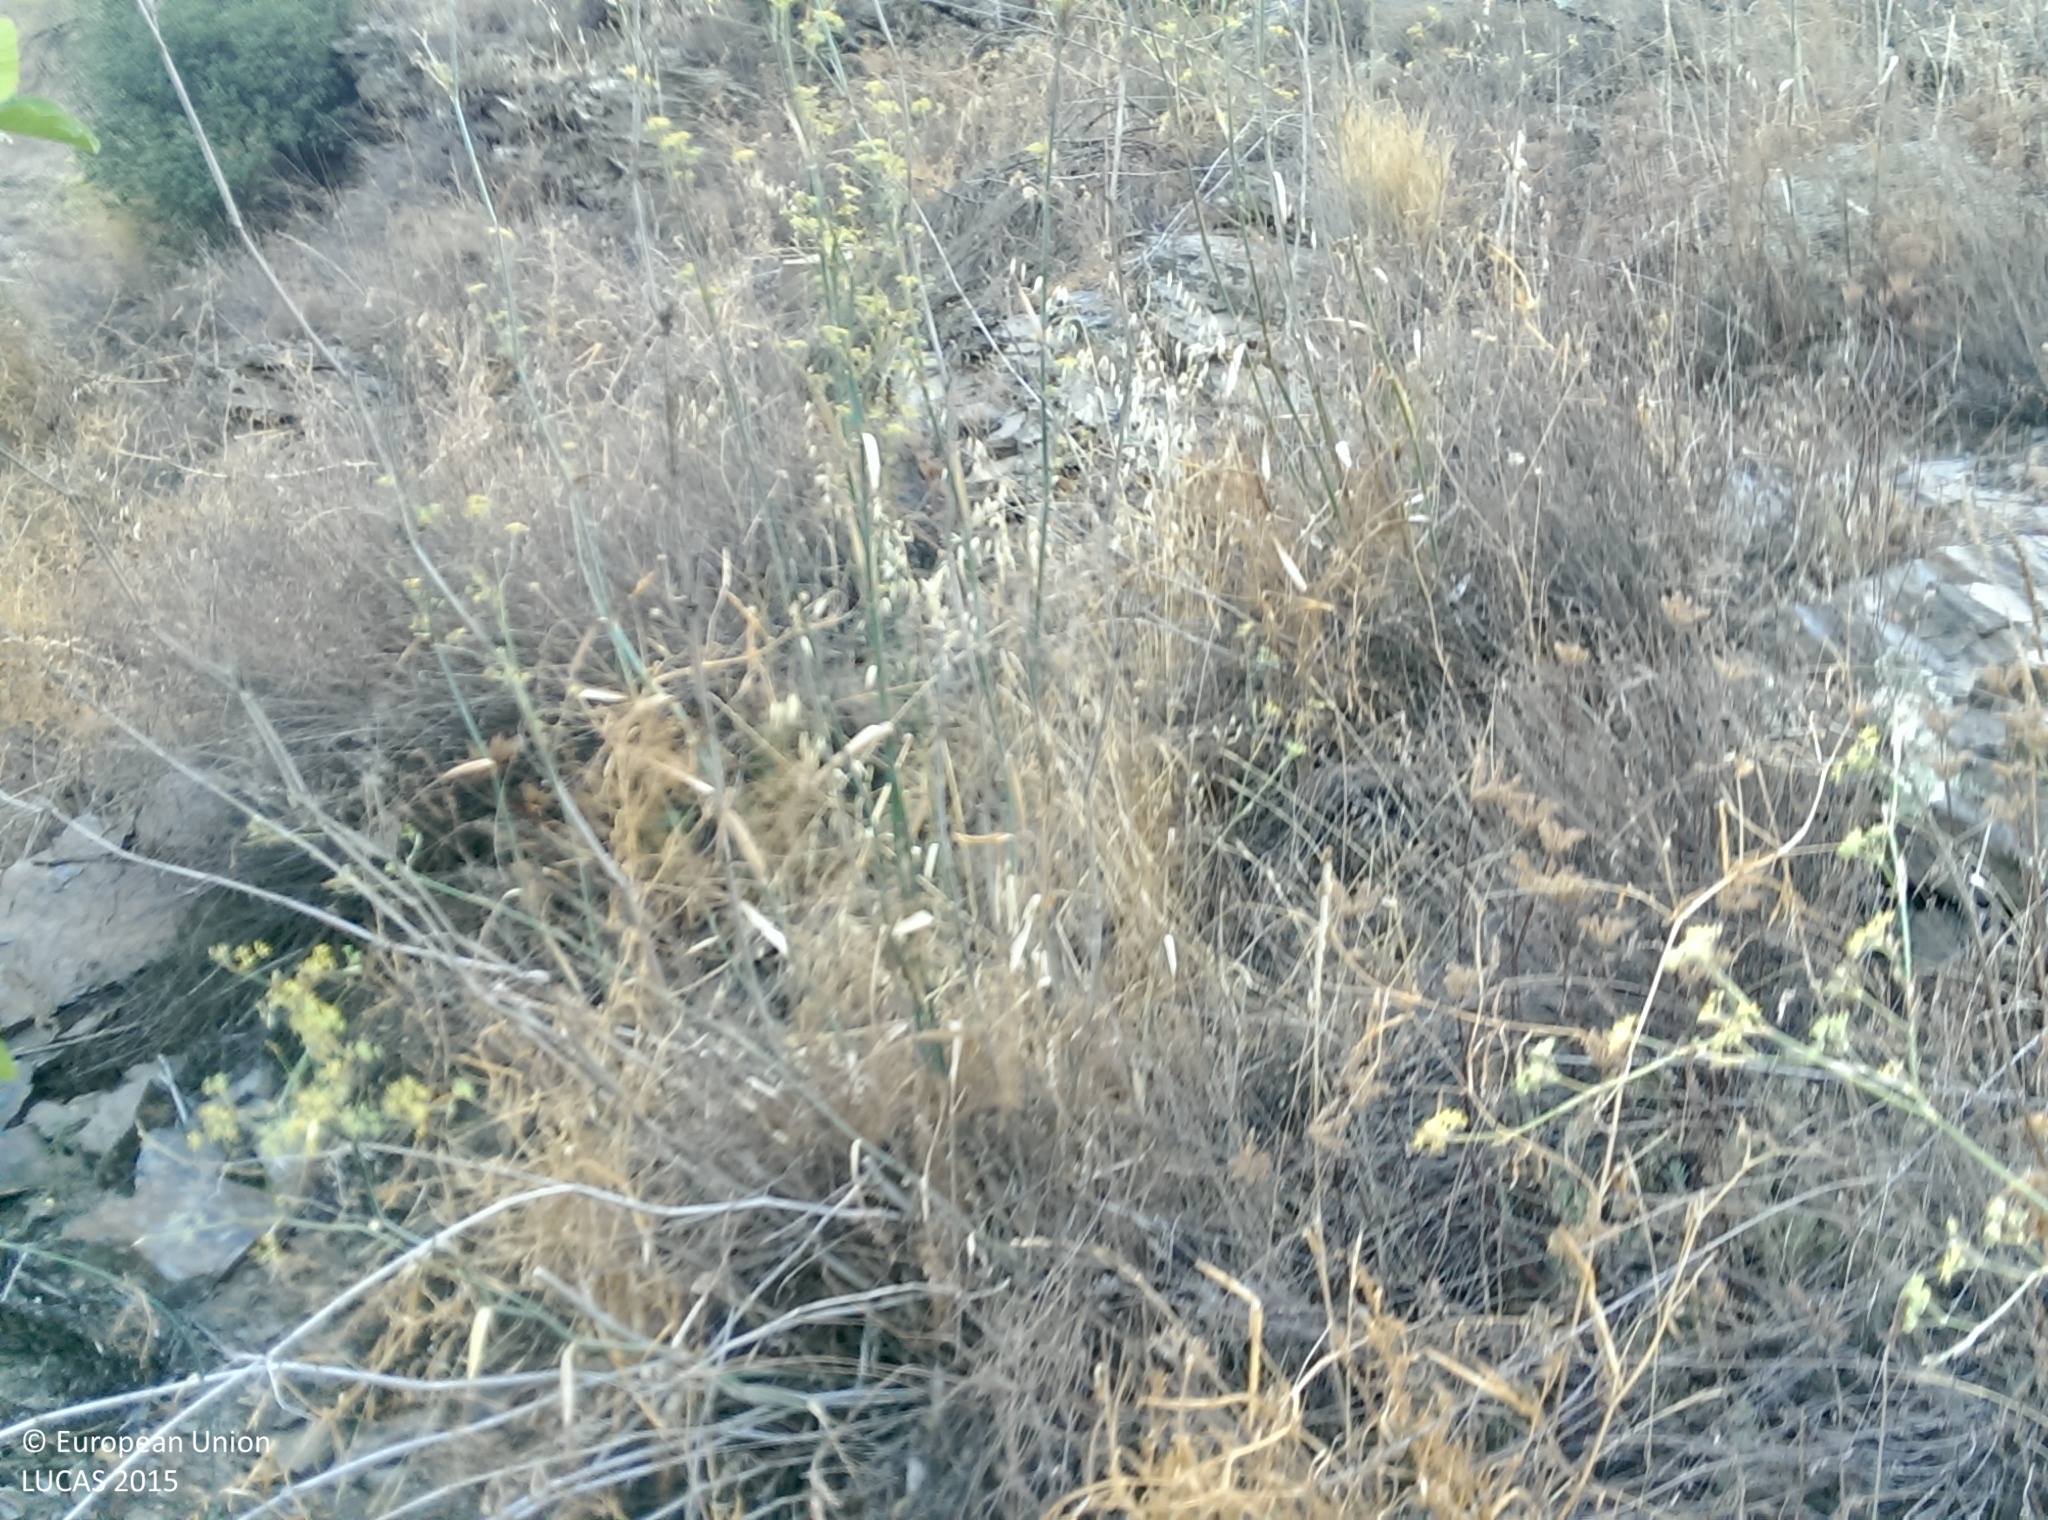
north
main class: Cropland
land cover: Nuts trees
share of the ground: 10 - 25 %
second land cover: Spontaneously vegetated surfaces
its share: 50 - 75 %
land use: Abandoned areas
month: August
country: ES
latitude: 36.7968
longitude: -3.1252
